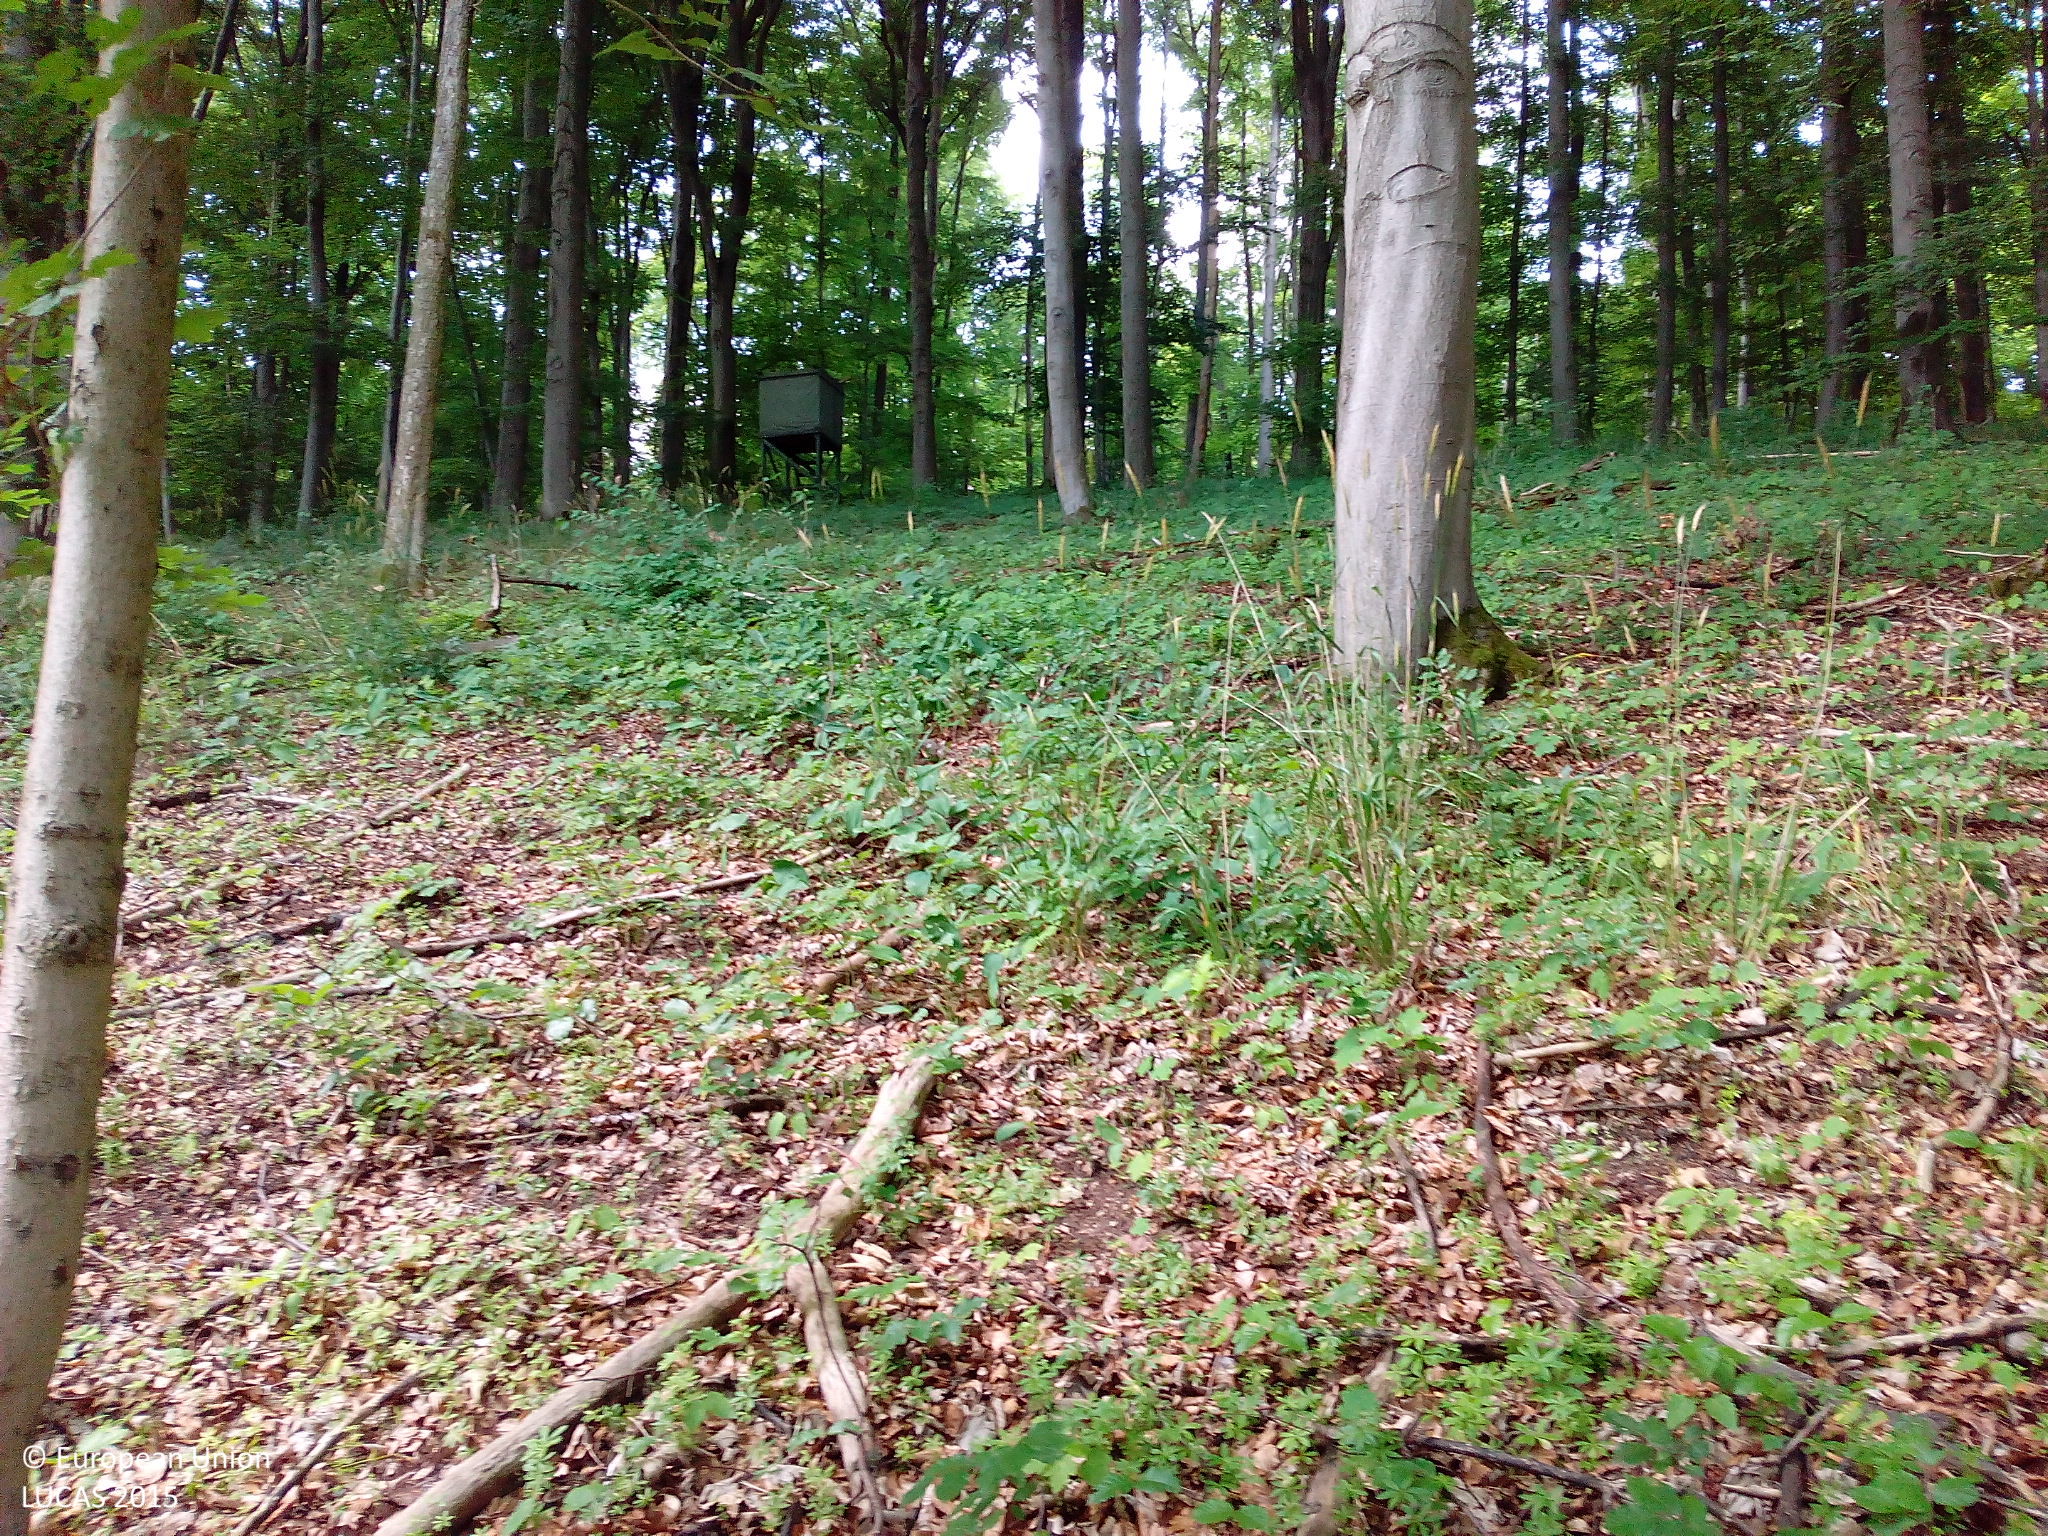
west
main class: Woodland
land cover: Broadleaved woodland
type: beech forest
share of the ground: > 75 %
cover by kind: broadleaved forest trees 90 %, herbaceous plants 5 %, unconsolidated bare surface 5 %
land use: Forestry
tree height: > 5 m
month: July
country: DE
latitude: 50.7416
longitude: 9.9008
